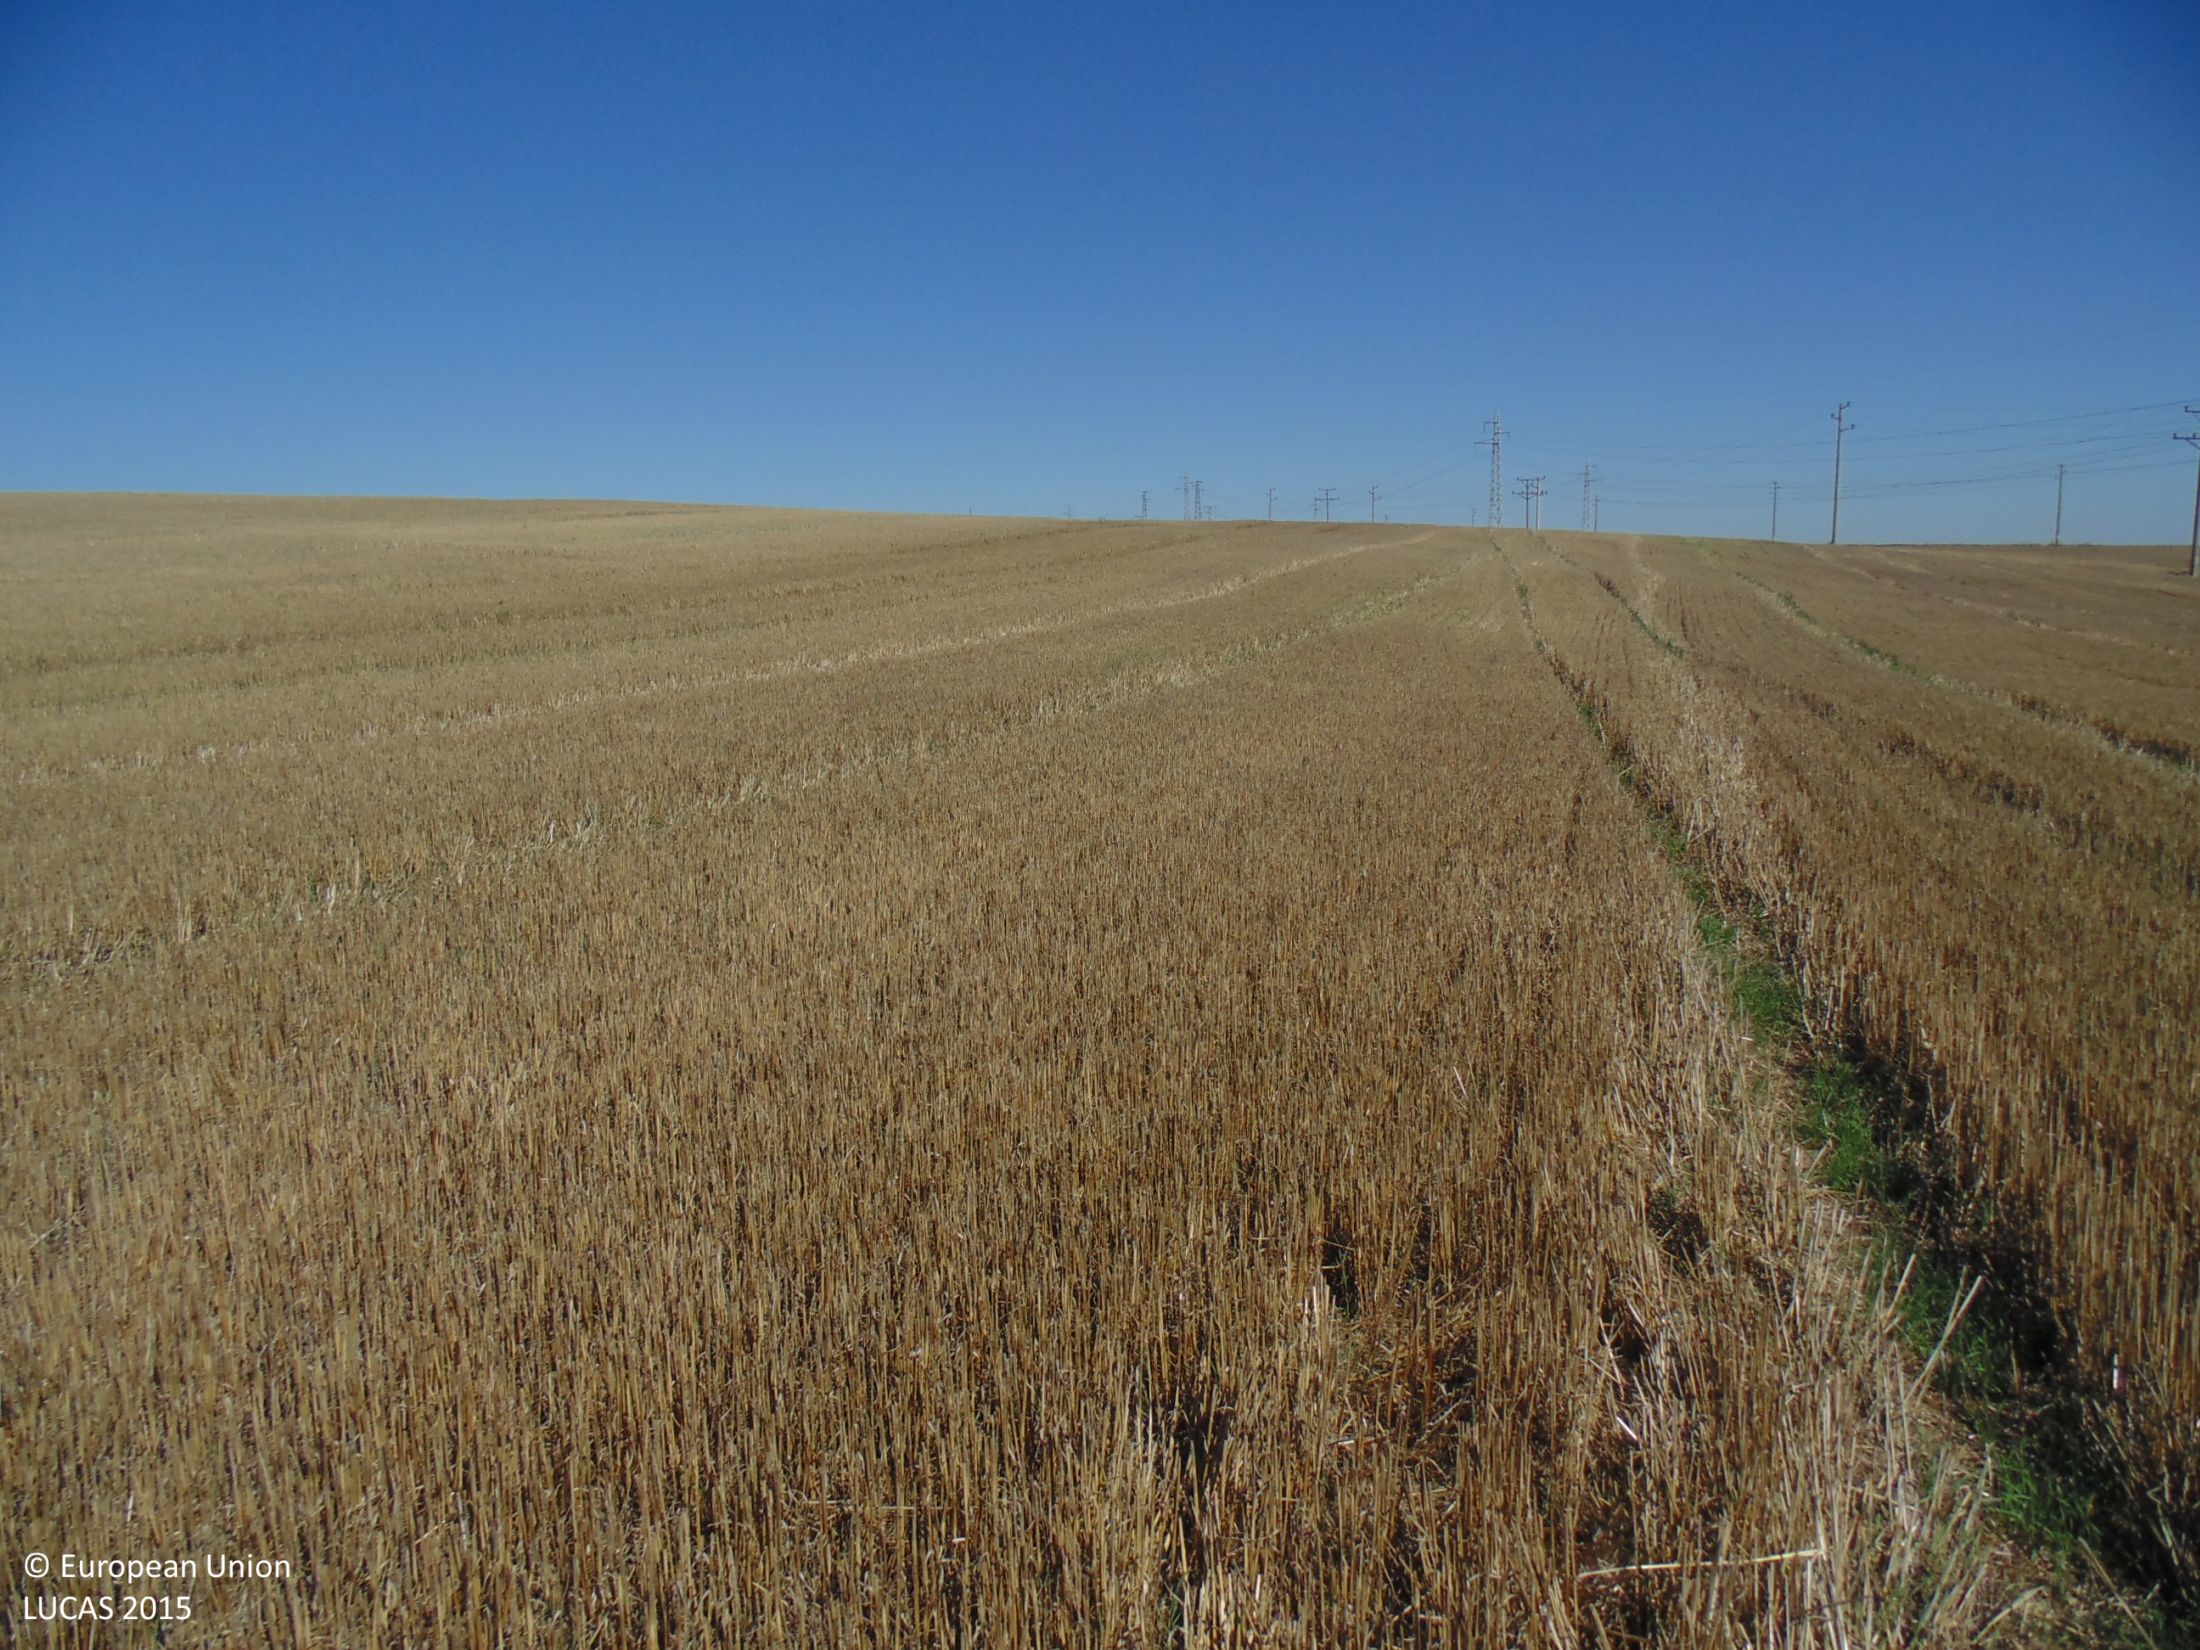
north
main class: Cropland
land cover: Common wheat
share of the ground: > 75 %
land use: Agriculture (excluding fallow land and kitchen gardens)
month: September
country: BG
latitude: 43.8302
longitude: 27.1495
